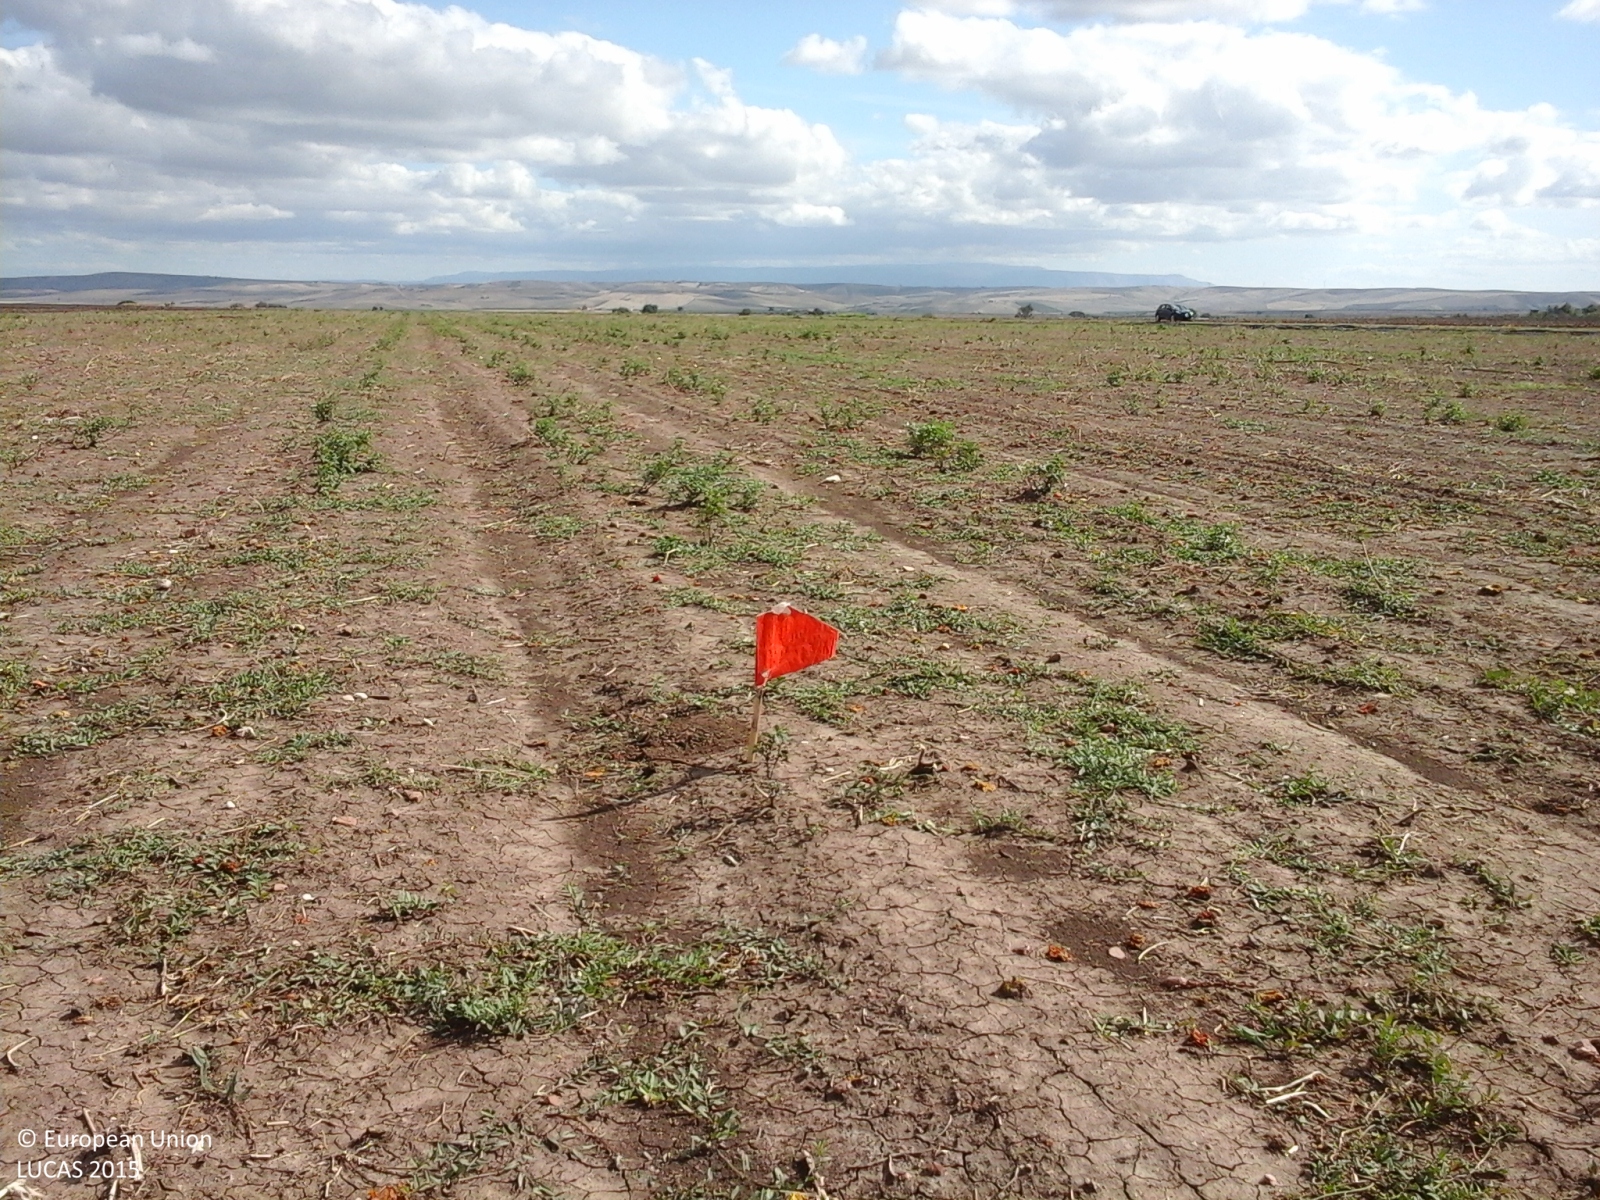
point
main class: Cropland
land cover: Tomatoes
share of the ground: < 10 %
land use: Agriculture (excluding fallow land and kitchen gardens)
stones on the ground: < 10 %
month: September
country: IT
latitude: 41.6730
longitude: 15.1363
